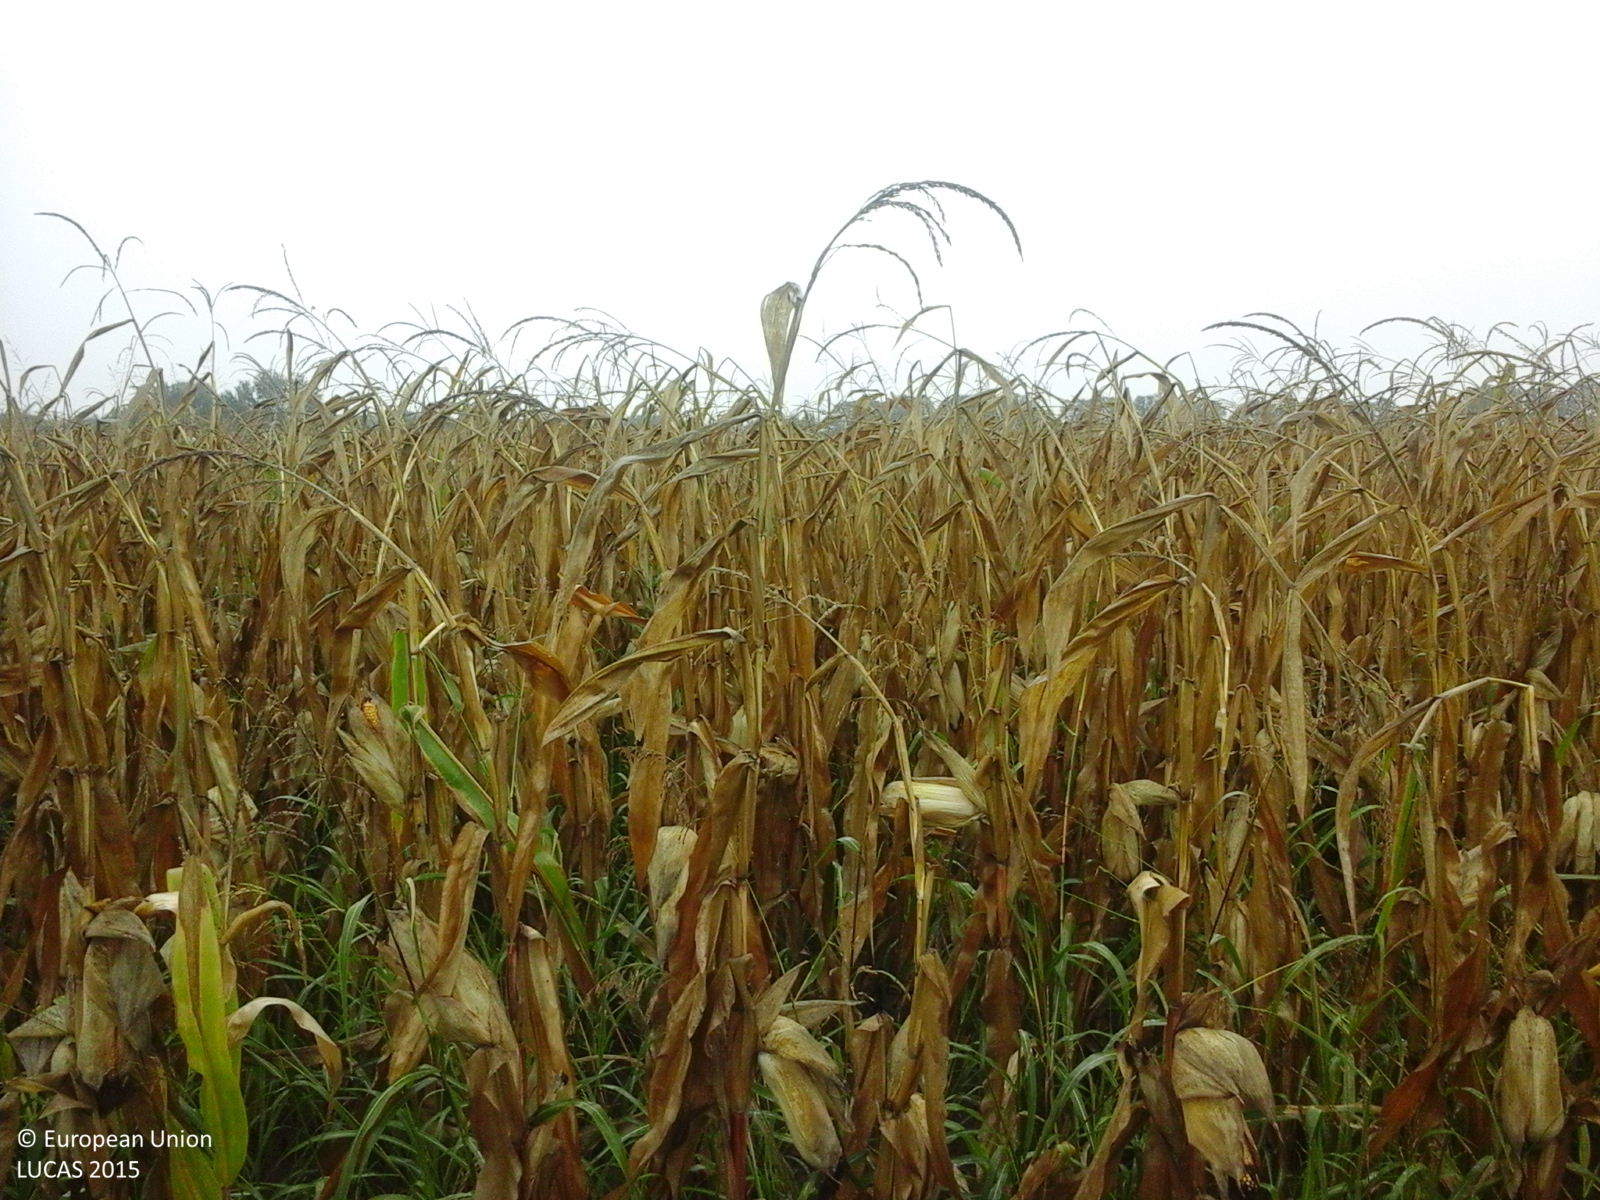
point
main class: Cropland
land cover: Maize
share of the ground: > 75 %
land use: Agriculture (excluding fallow land and kitchen gardens)
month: September
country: RO
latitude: 47.4445
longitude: 22.1053
